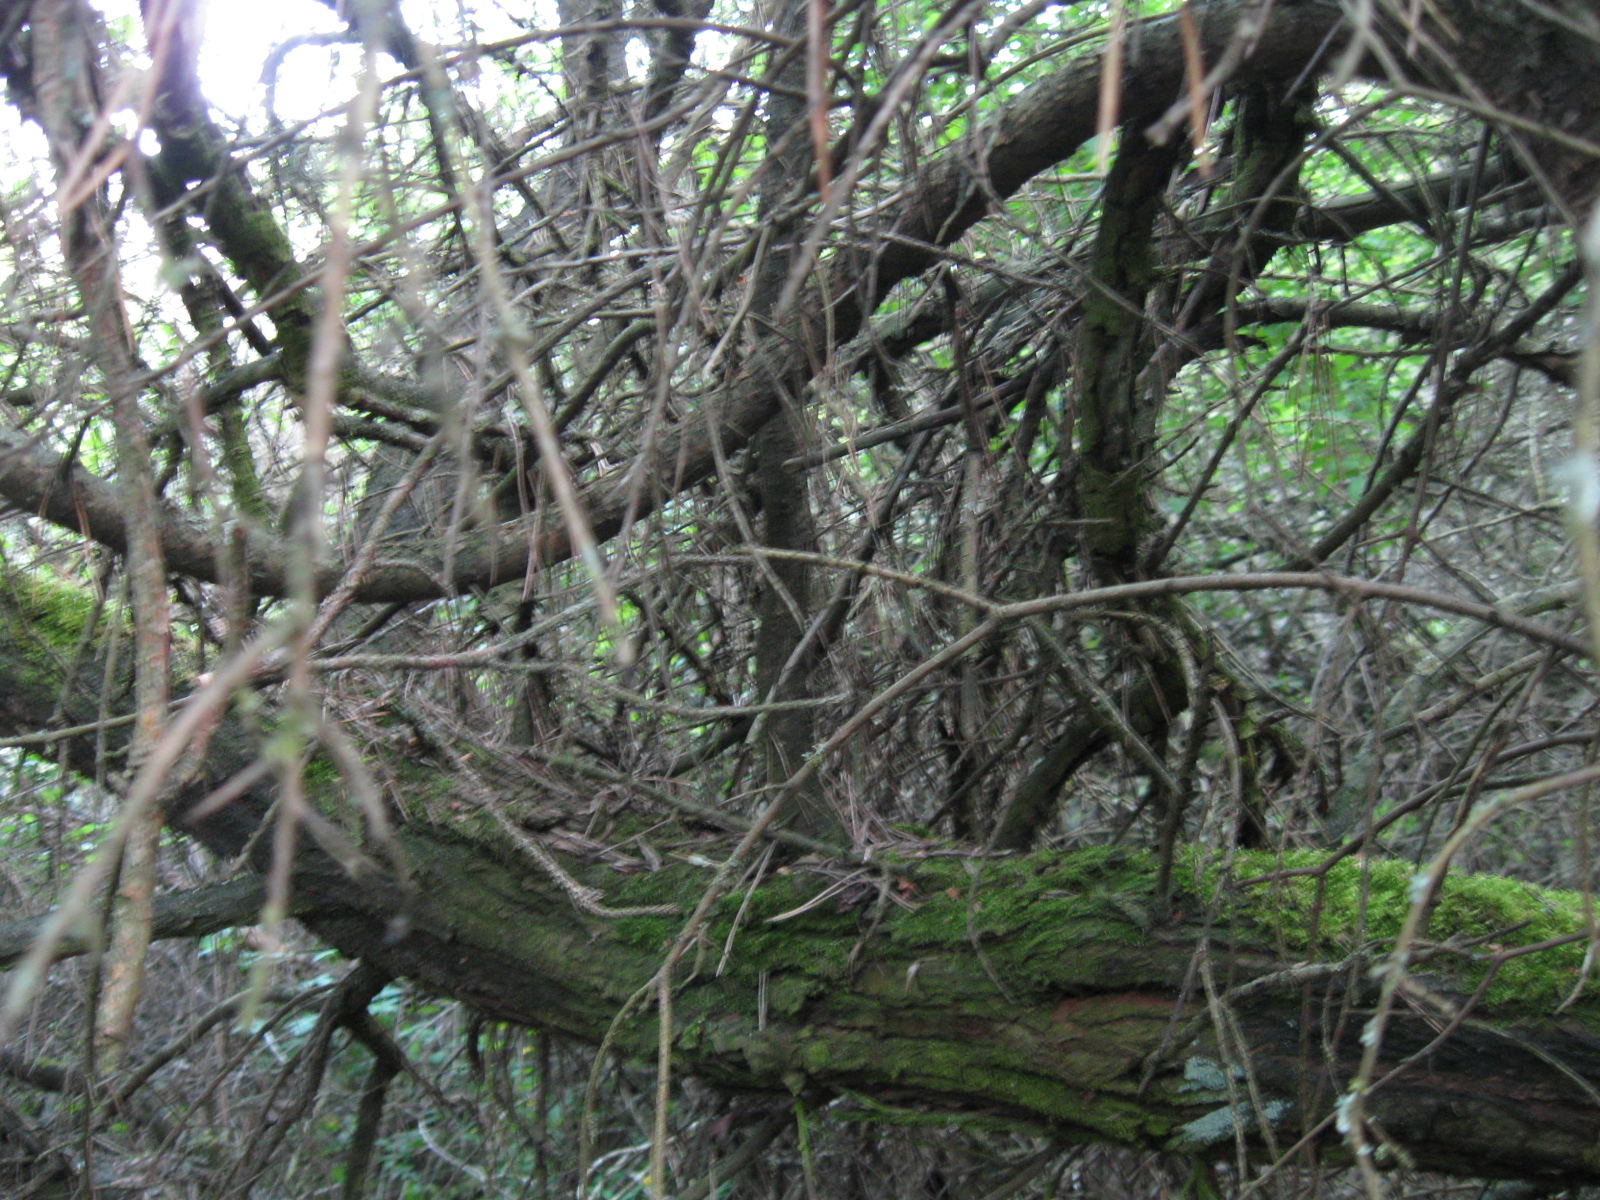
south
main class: Woodland
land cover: Other mixed woodland
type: hemiboreal forest and nemoral coniferous forest and mixed broadleaved-coniferous forest
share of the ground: > 75 %
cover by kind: broadleaved forest trees 70 %, coniferous forest trees 30 %
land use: Forestry
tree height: > 5 m
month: June
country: LT
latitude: 54.1660
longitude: 23.7344
